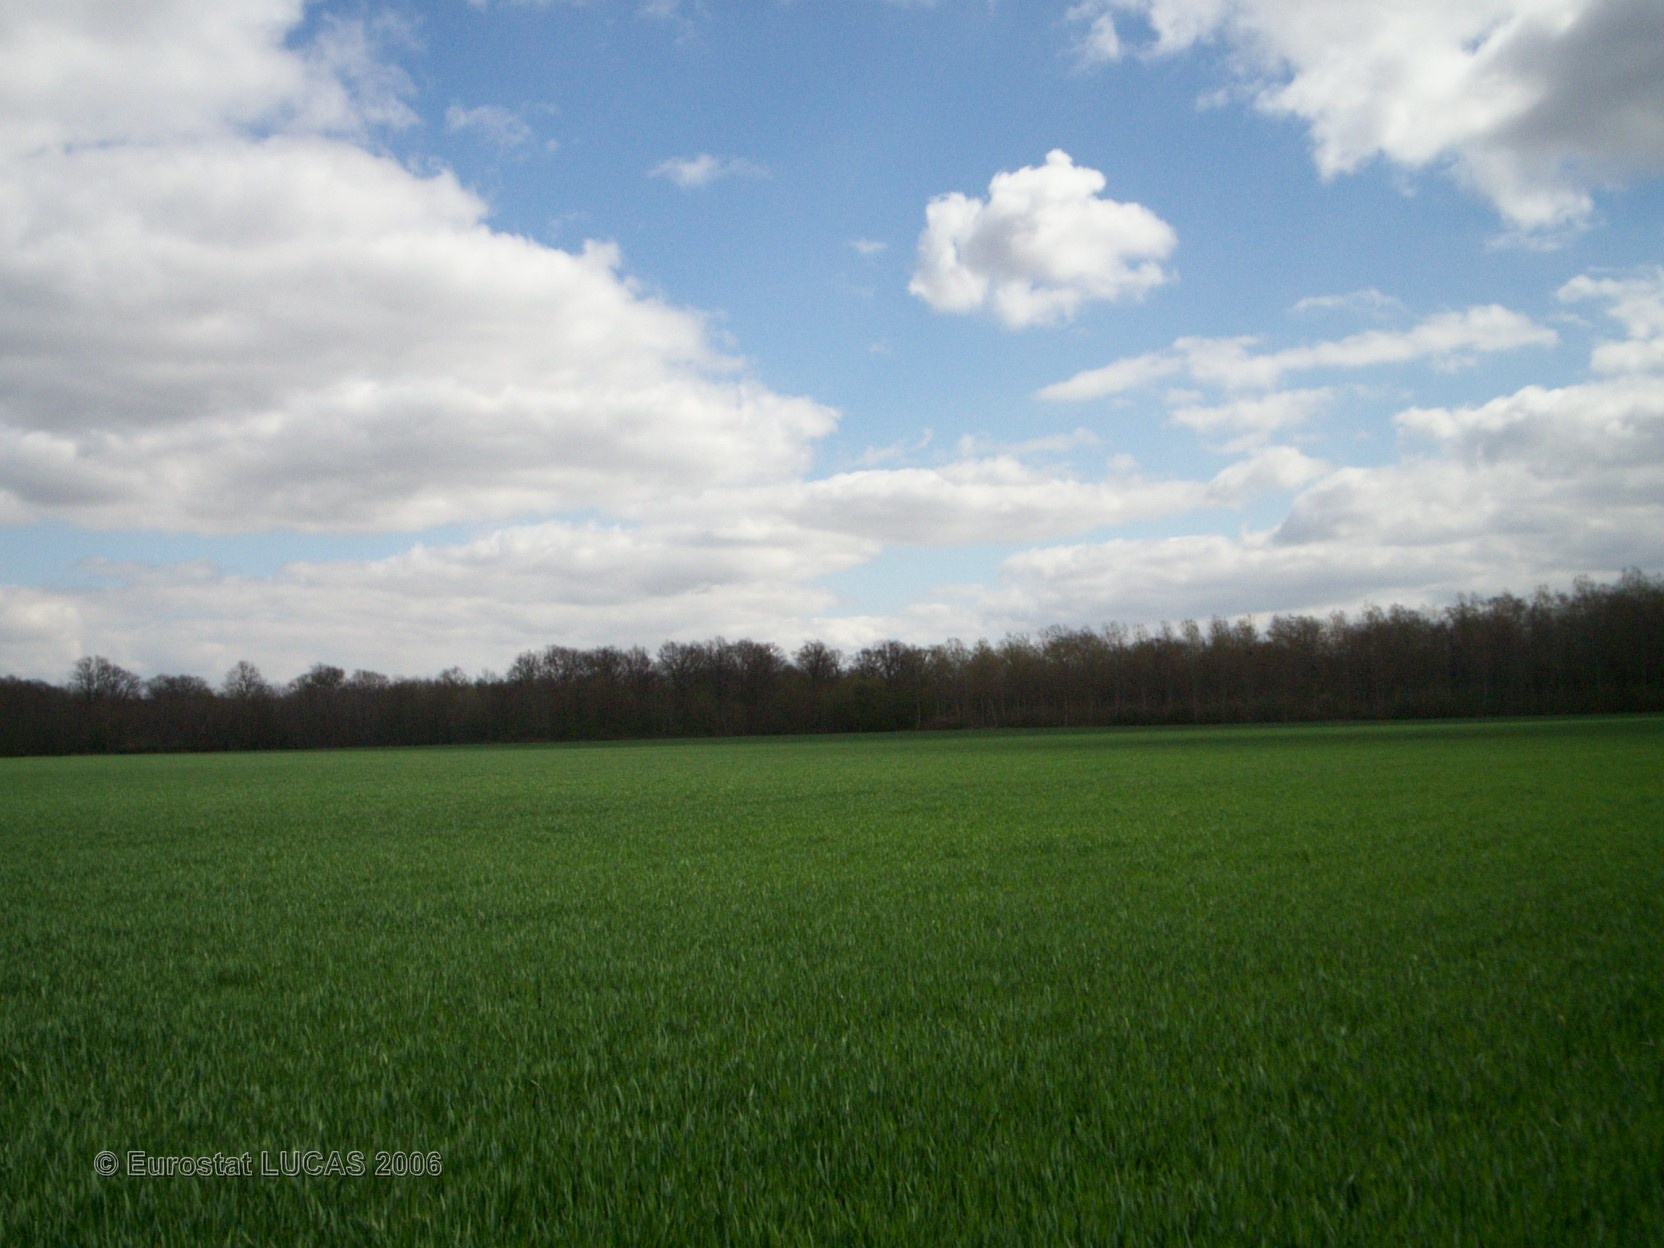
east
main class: Cropland
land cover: Common wheat
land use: Agriculture (excluding fallow land and kitchen gardens)
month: April
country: FR
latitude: 48.5334
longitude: 2.8542
